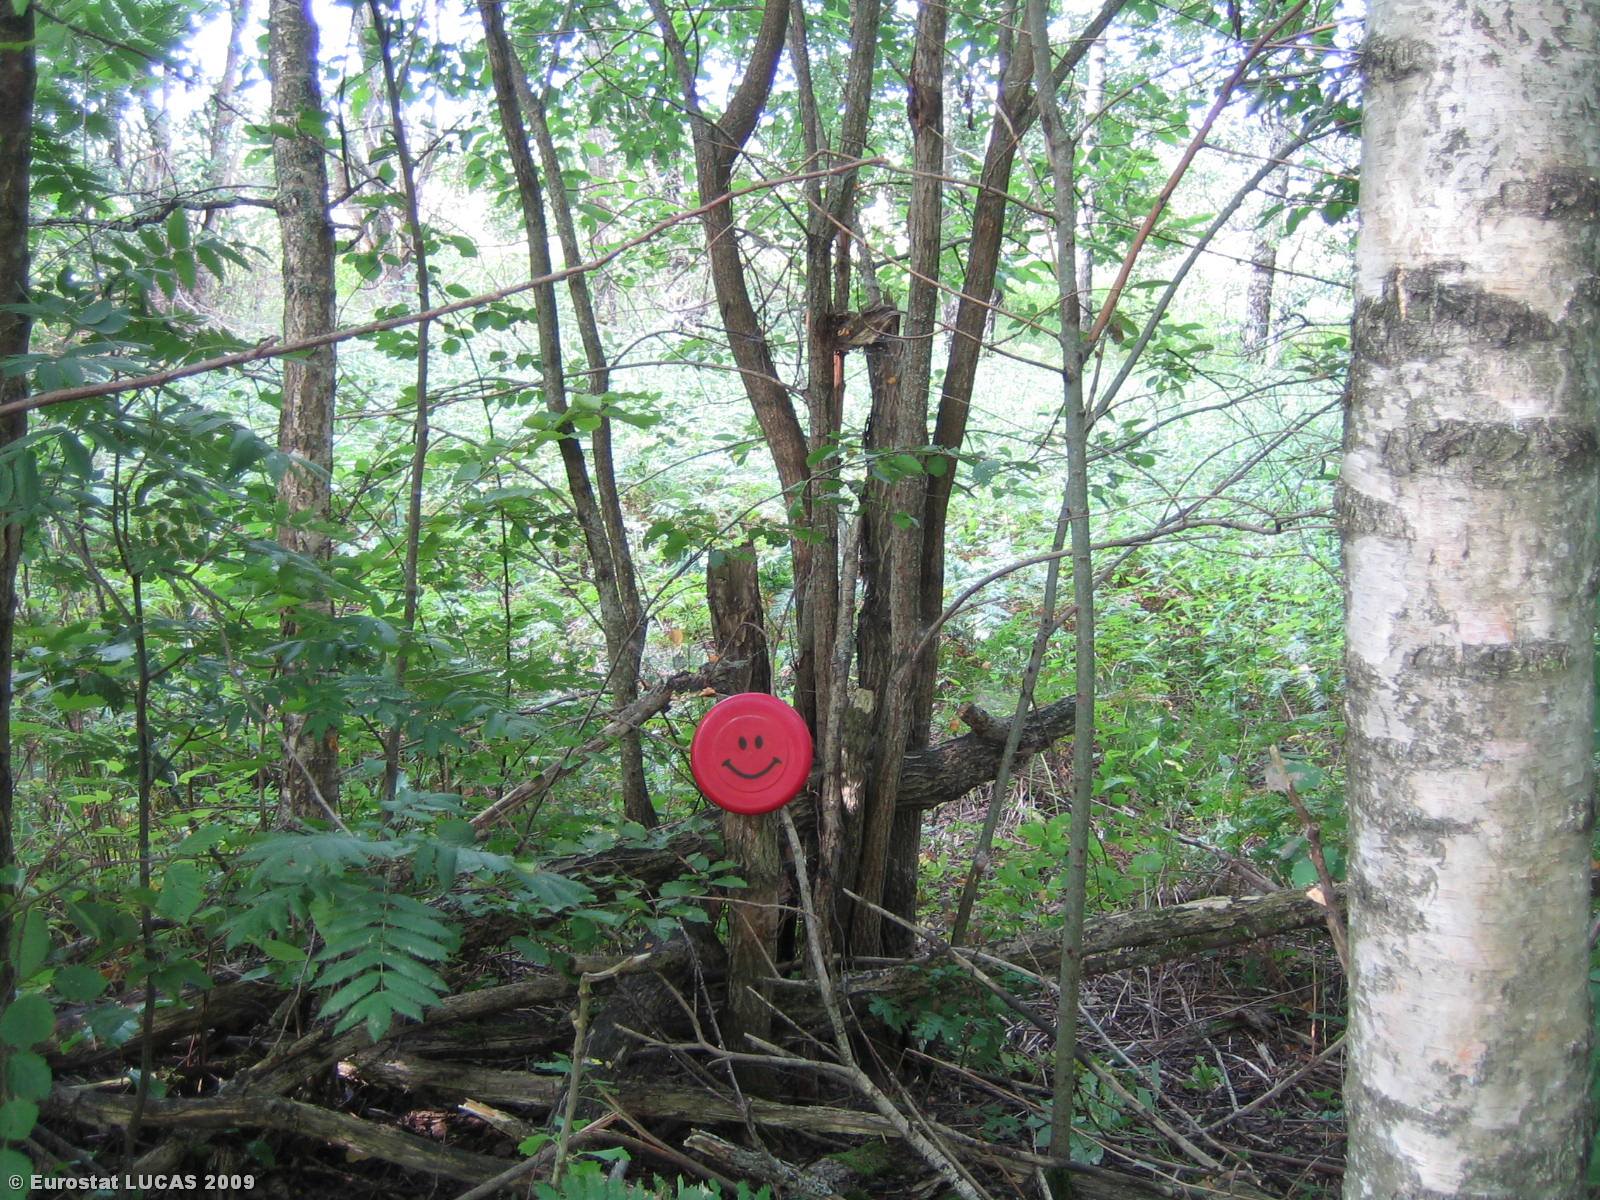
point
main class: Woodland
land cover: Broadleaved woodland
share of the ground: > 75 %
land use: Forestry
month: August
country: LT
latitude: 54.5453
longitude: 24.7162
